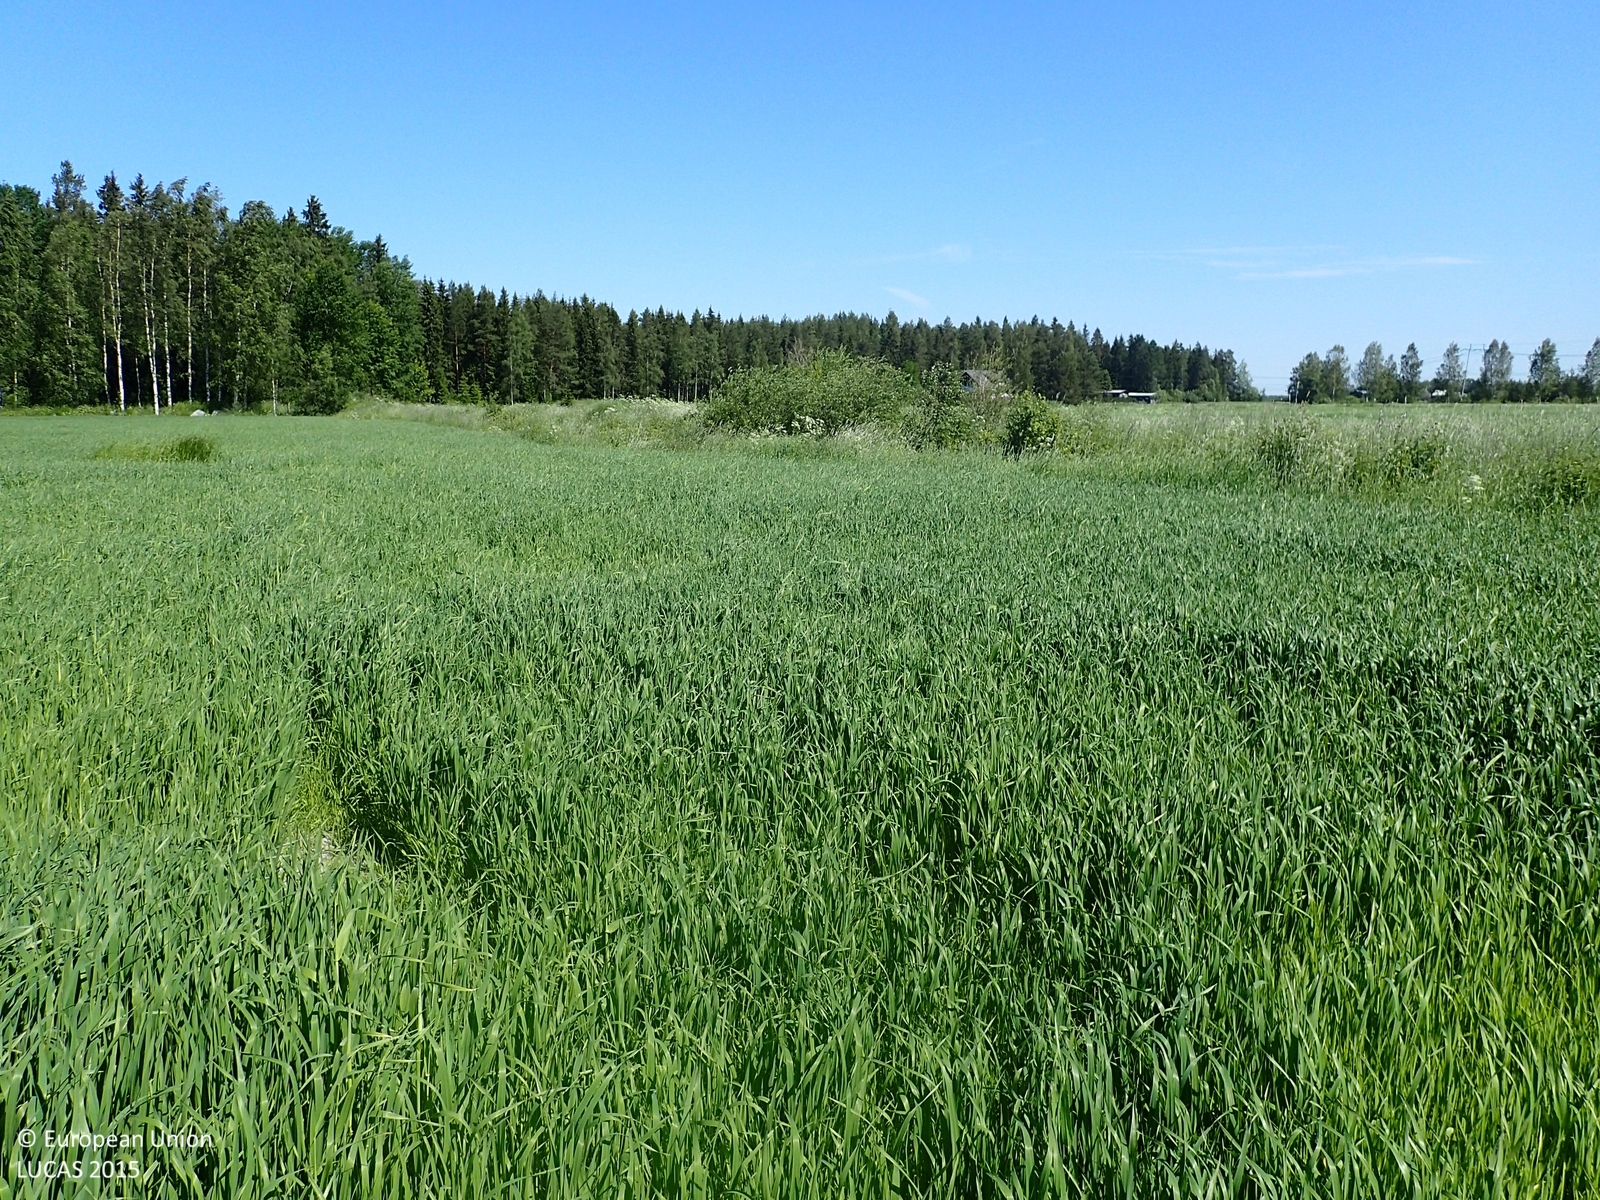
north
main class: Cropland
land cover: Oats
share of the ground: > 75 %
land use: Agriculture (excluding fallow land and kitchen gardens)
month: July
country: FI
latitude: 62.6129
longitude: 21.4413
